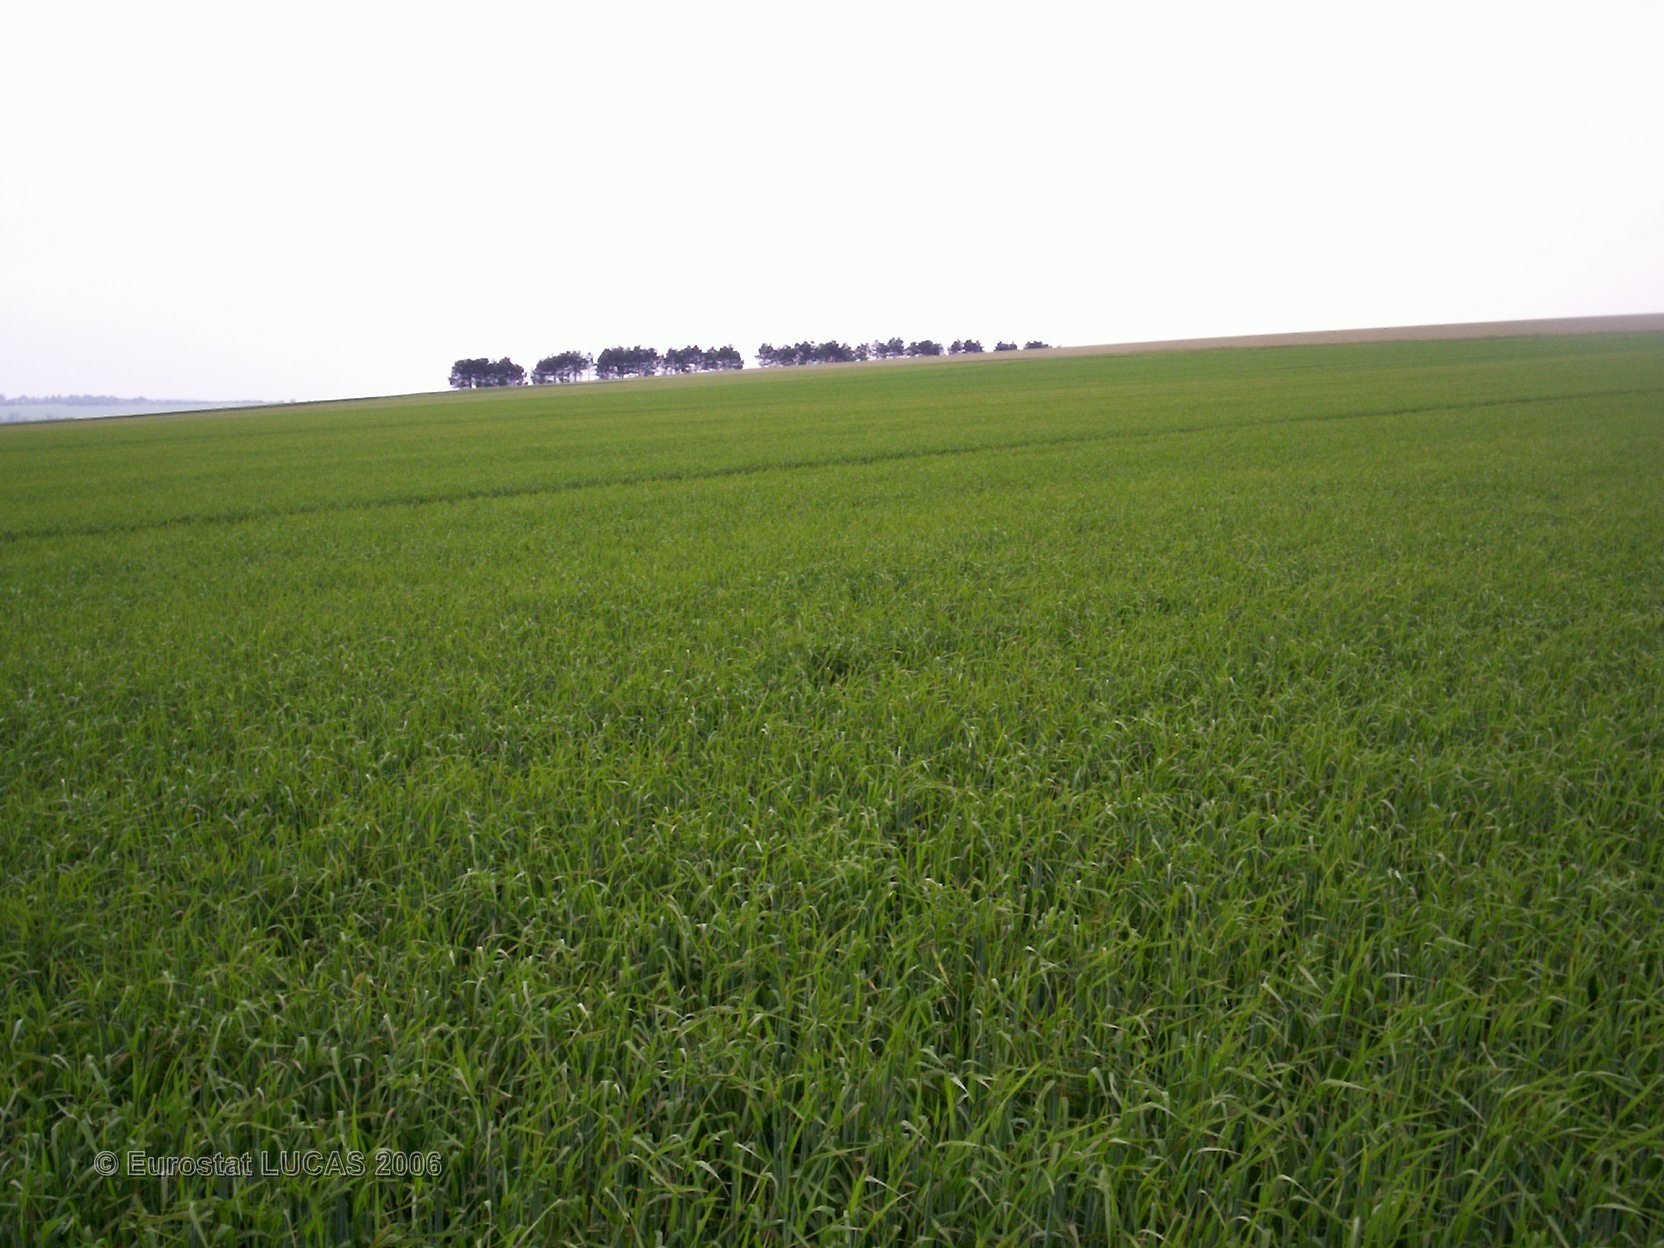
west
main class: Cropland
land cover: Barley
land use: Agriculture (excluding fallow land and kitchen gardens)
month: June
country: FR
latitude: 48.6427
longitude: 4.4460
